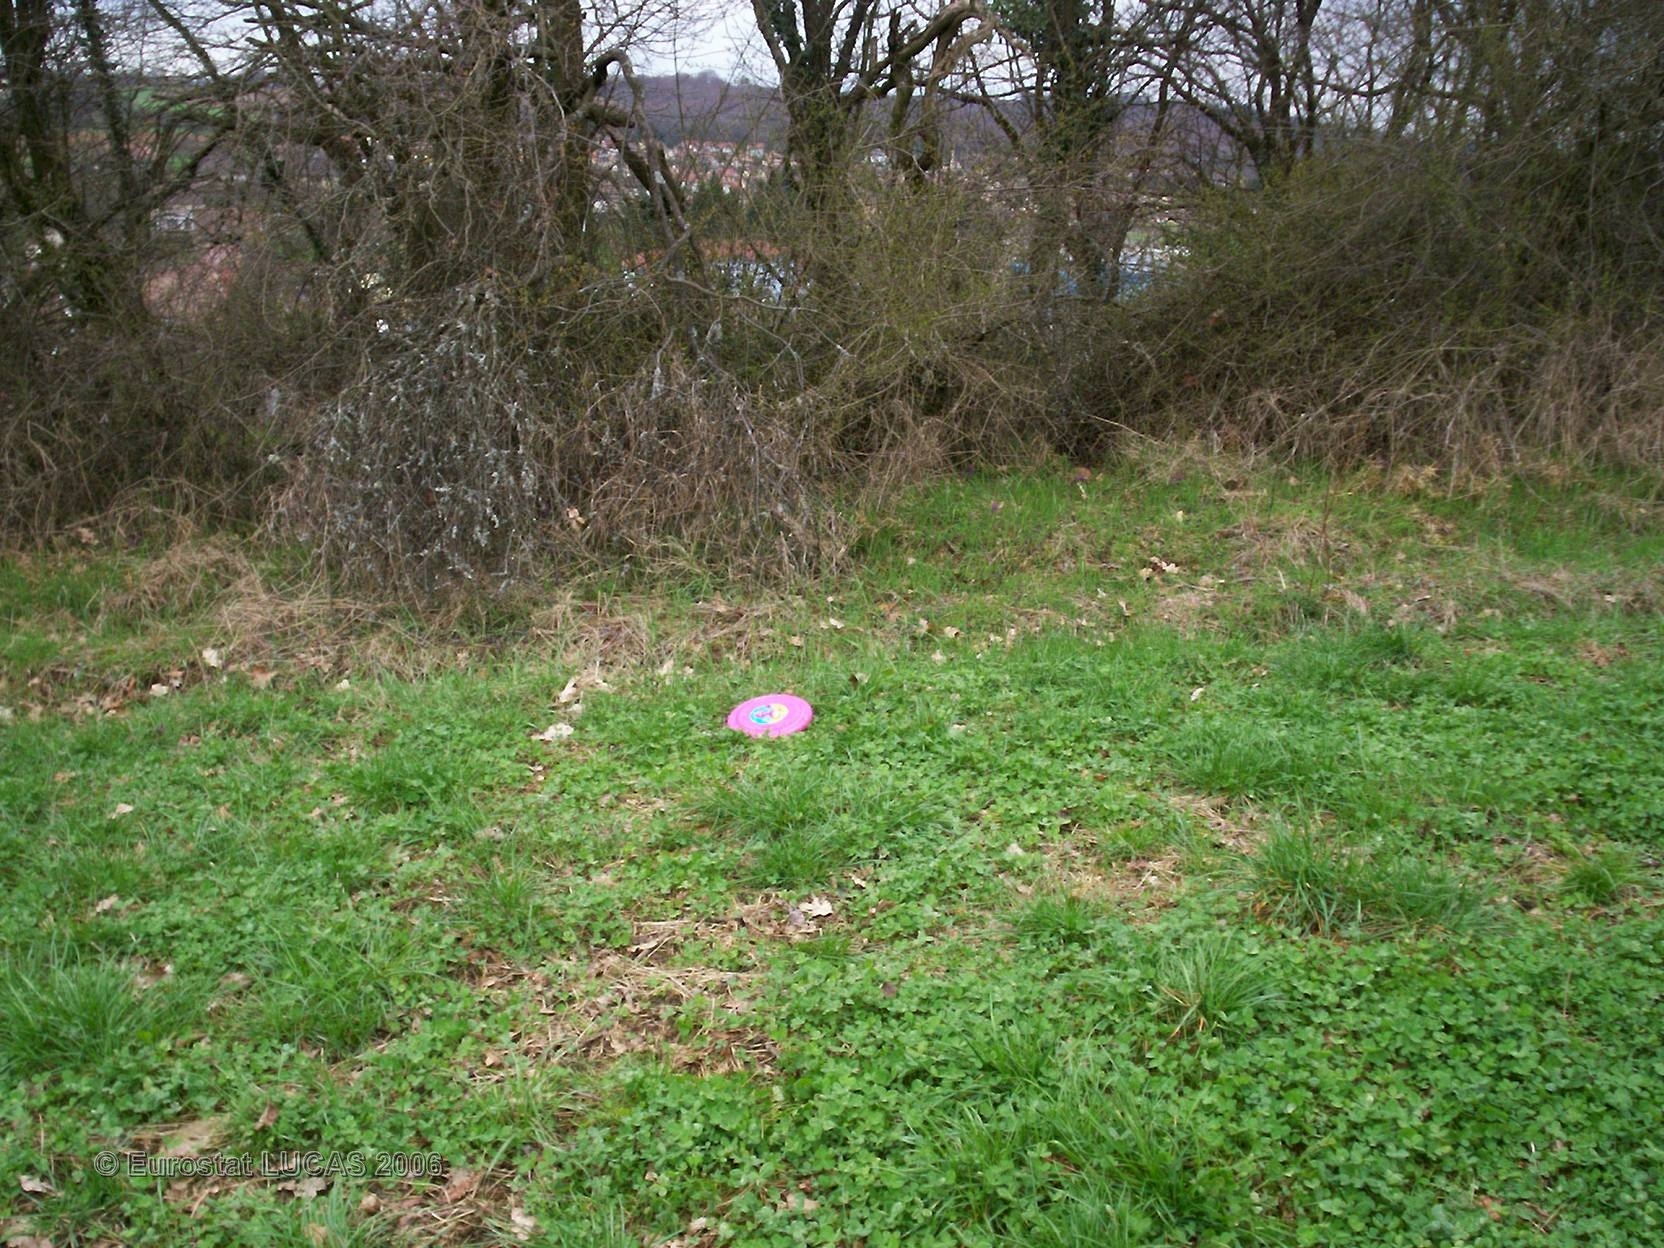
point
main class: Cropland
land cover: Clovers
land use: Agriculture (excluding fallow land and kitchen gardens)
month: April
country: FR
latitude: 47.5287
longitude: 6.8006
